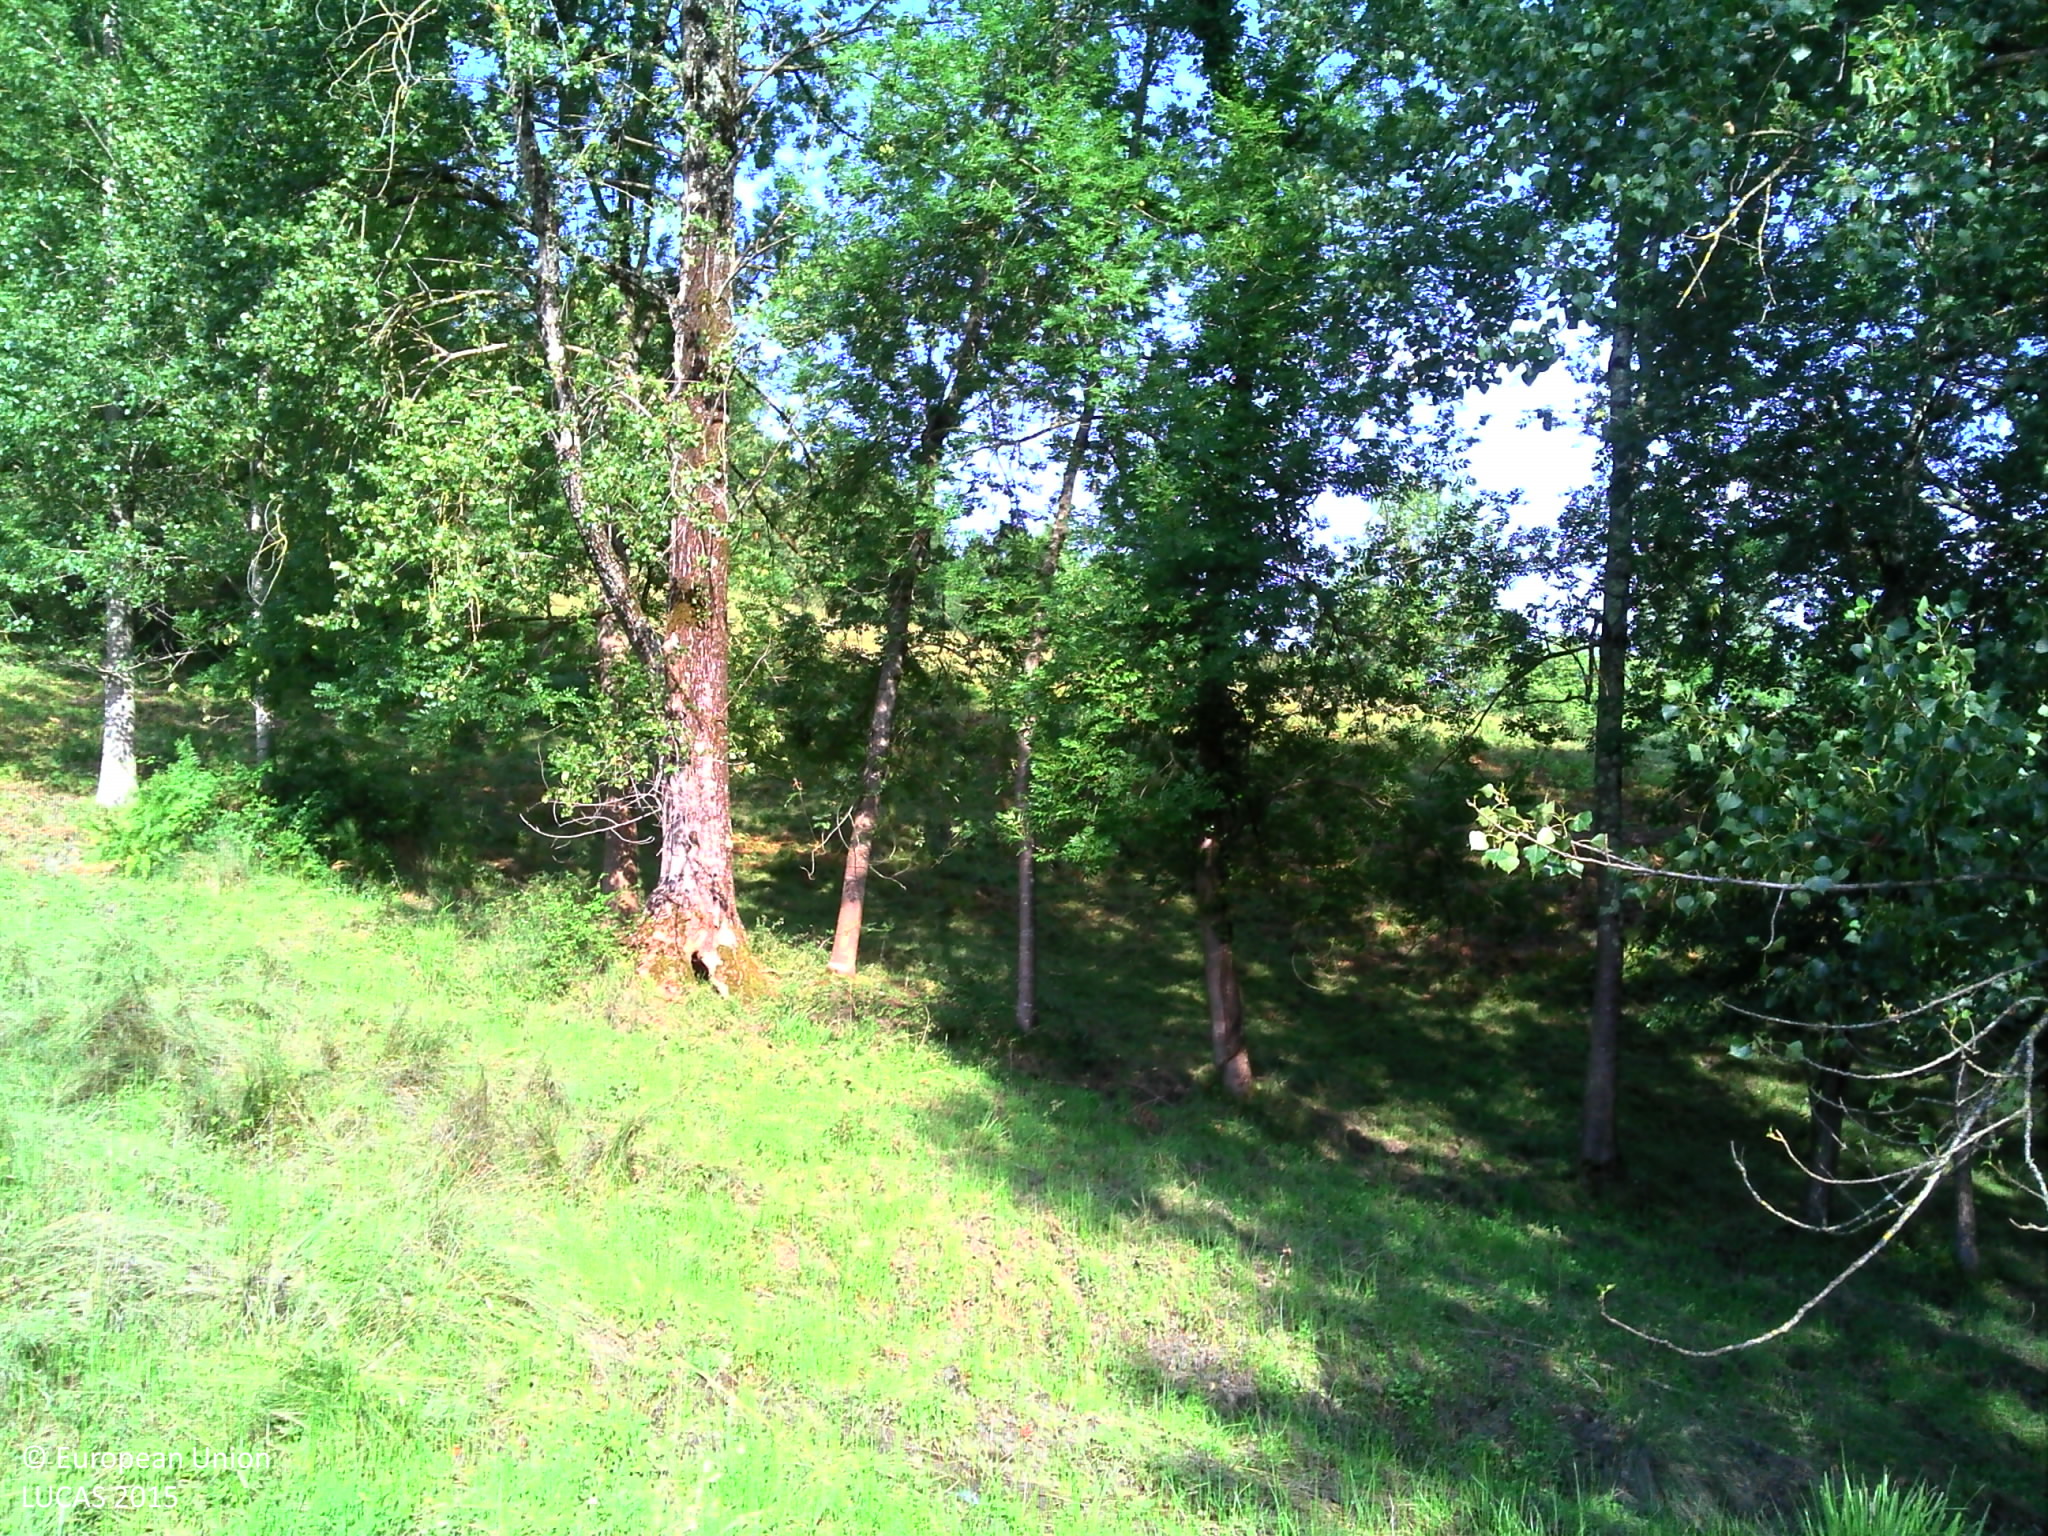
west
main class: Grassland
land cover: Spontaneously vegetated surfaces
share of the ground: > 75 %
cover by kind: herbaceous plants 100 %
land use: Agriculture (excluding fallow land and kitchen gardens)
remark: Temporary dry
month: July
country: FR
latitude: 43.0047
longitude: 1.0858
